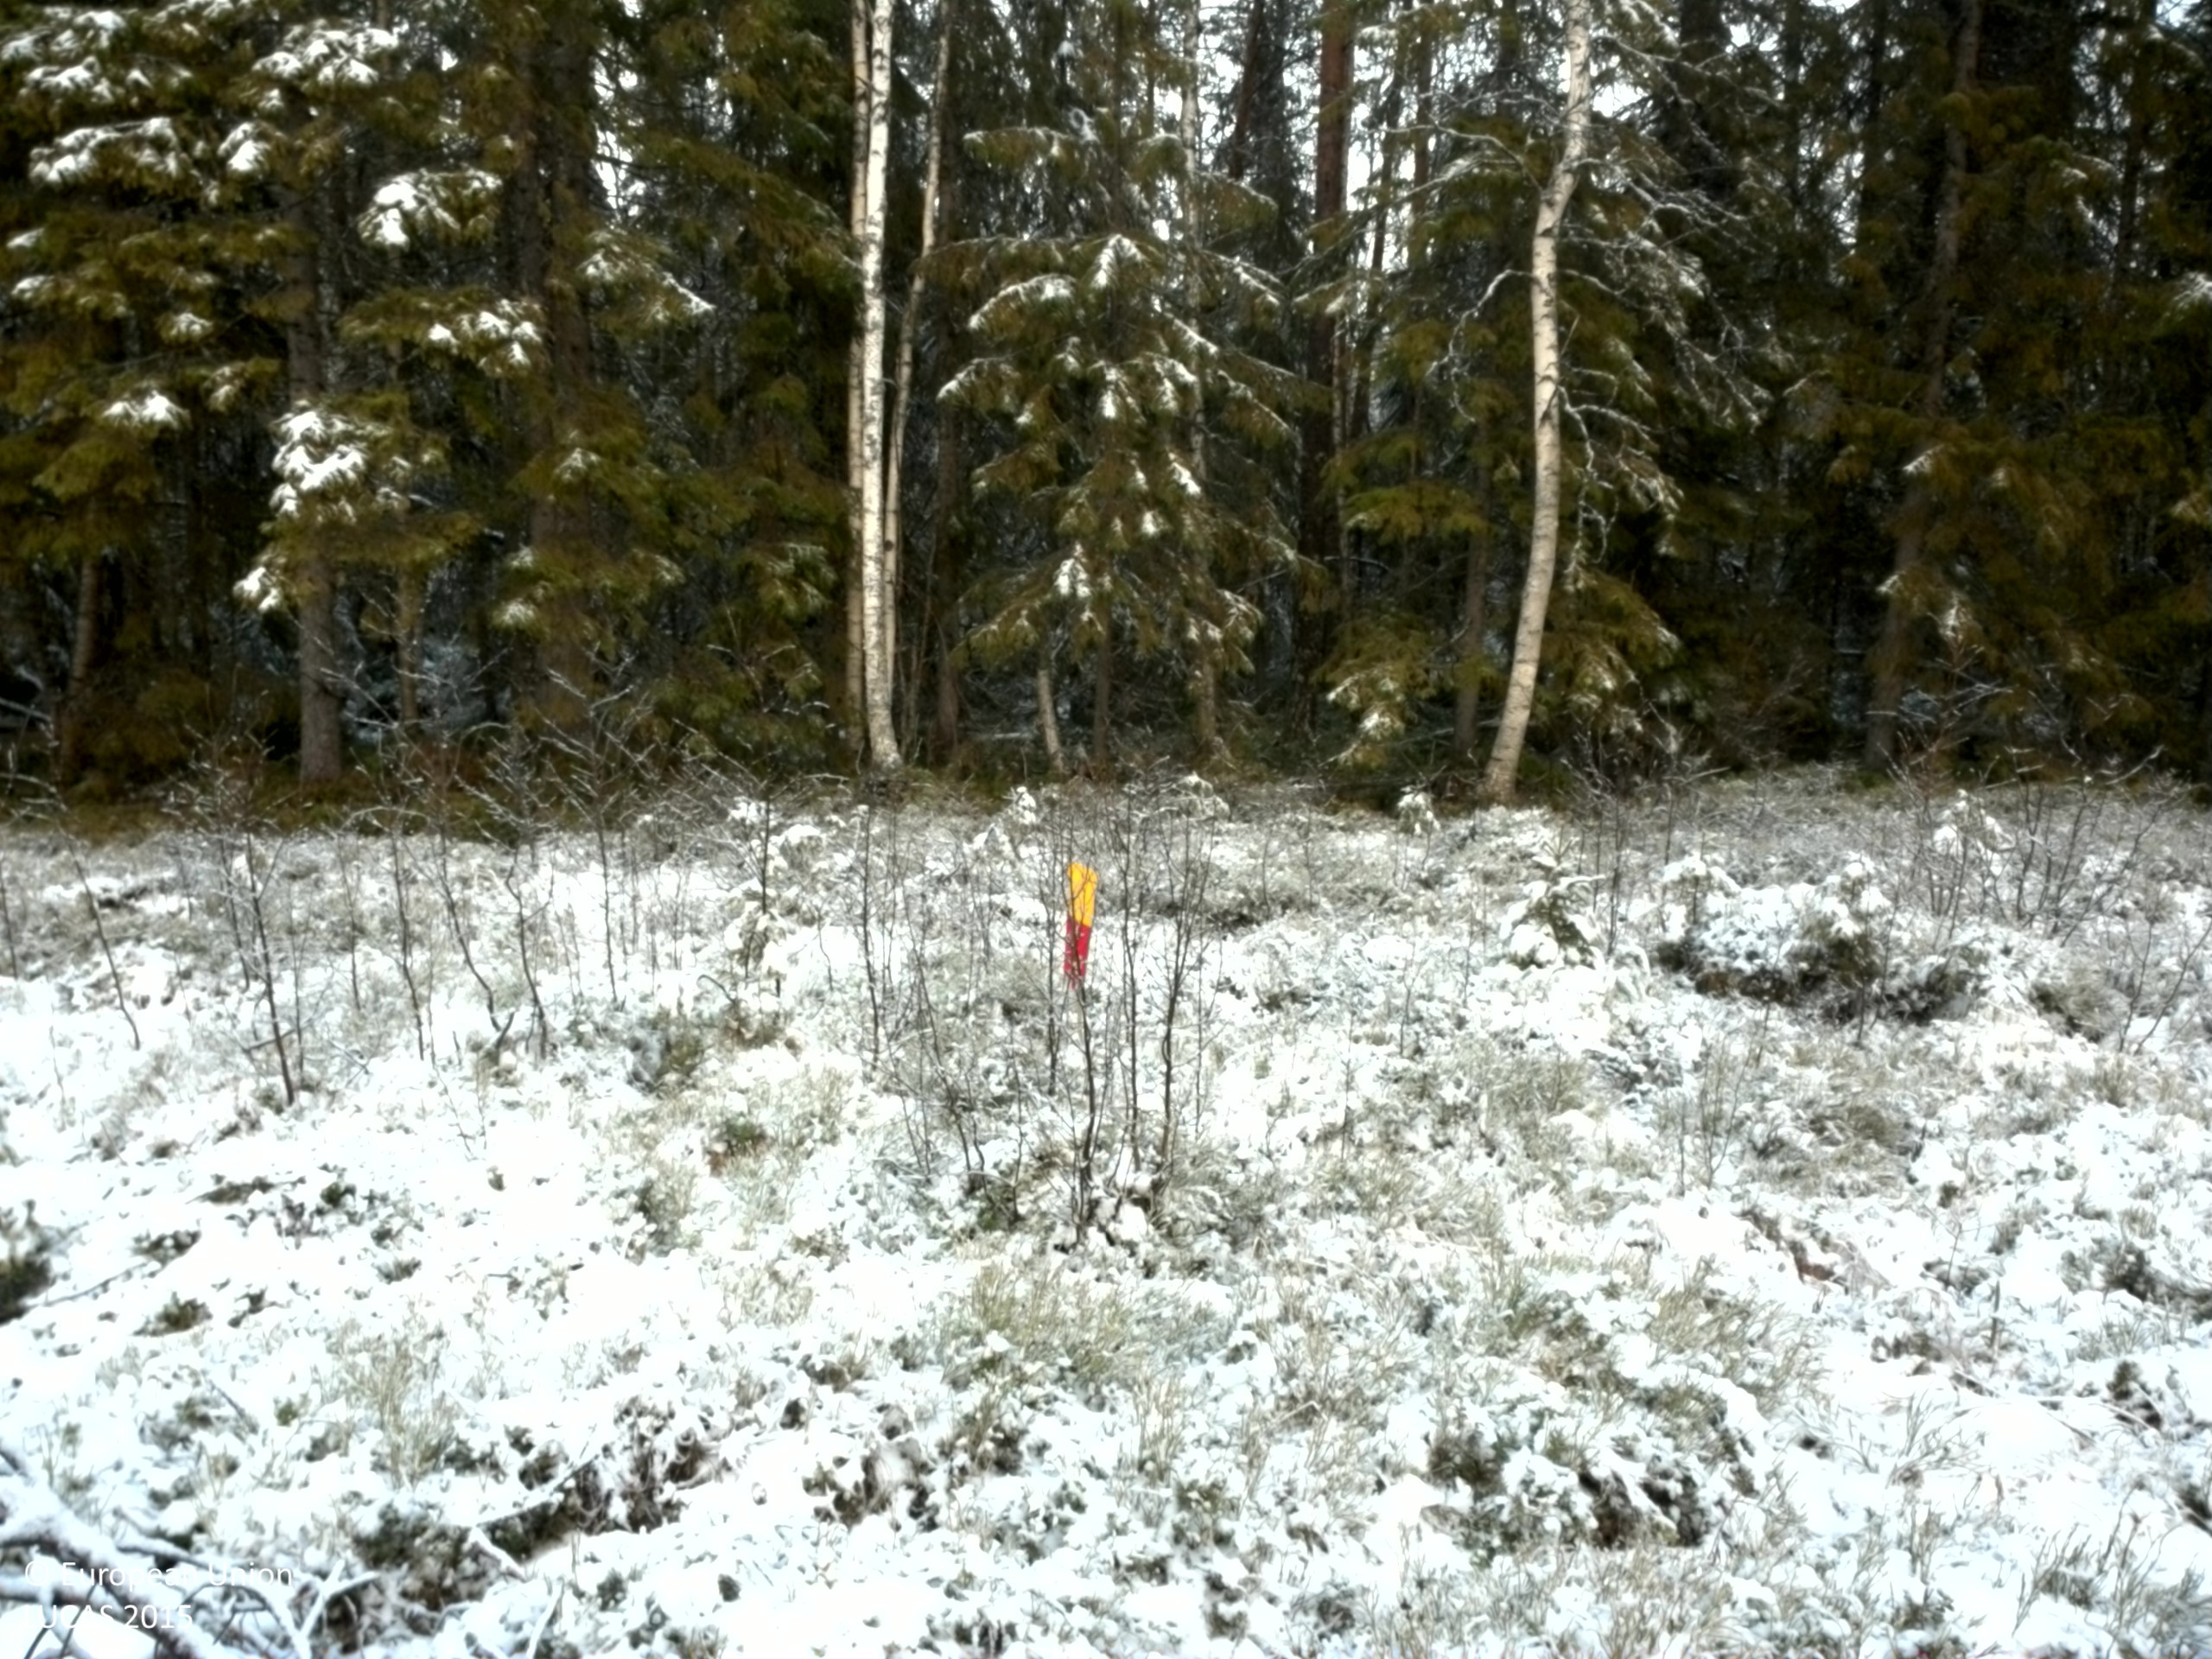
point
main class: Woodland
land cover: Broadleaved woodland
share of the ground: 10 - 25 %
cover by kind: shrubs 55 %, lichens and mosses 30 %, broadleaved forest trees 15 %
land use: Forestry
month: November
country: SE
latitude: 63.7567
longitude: 15.5884
